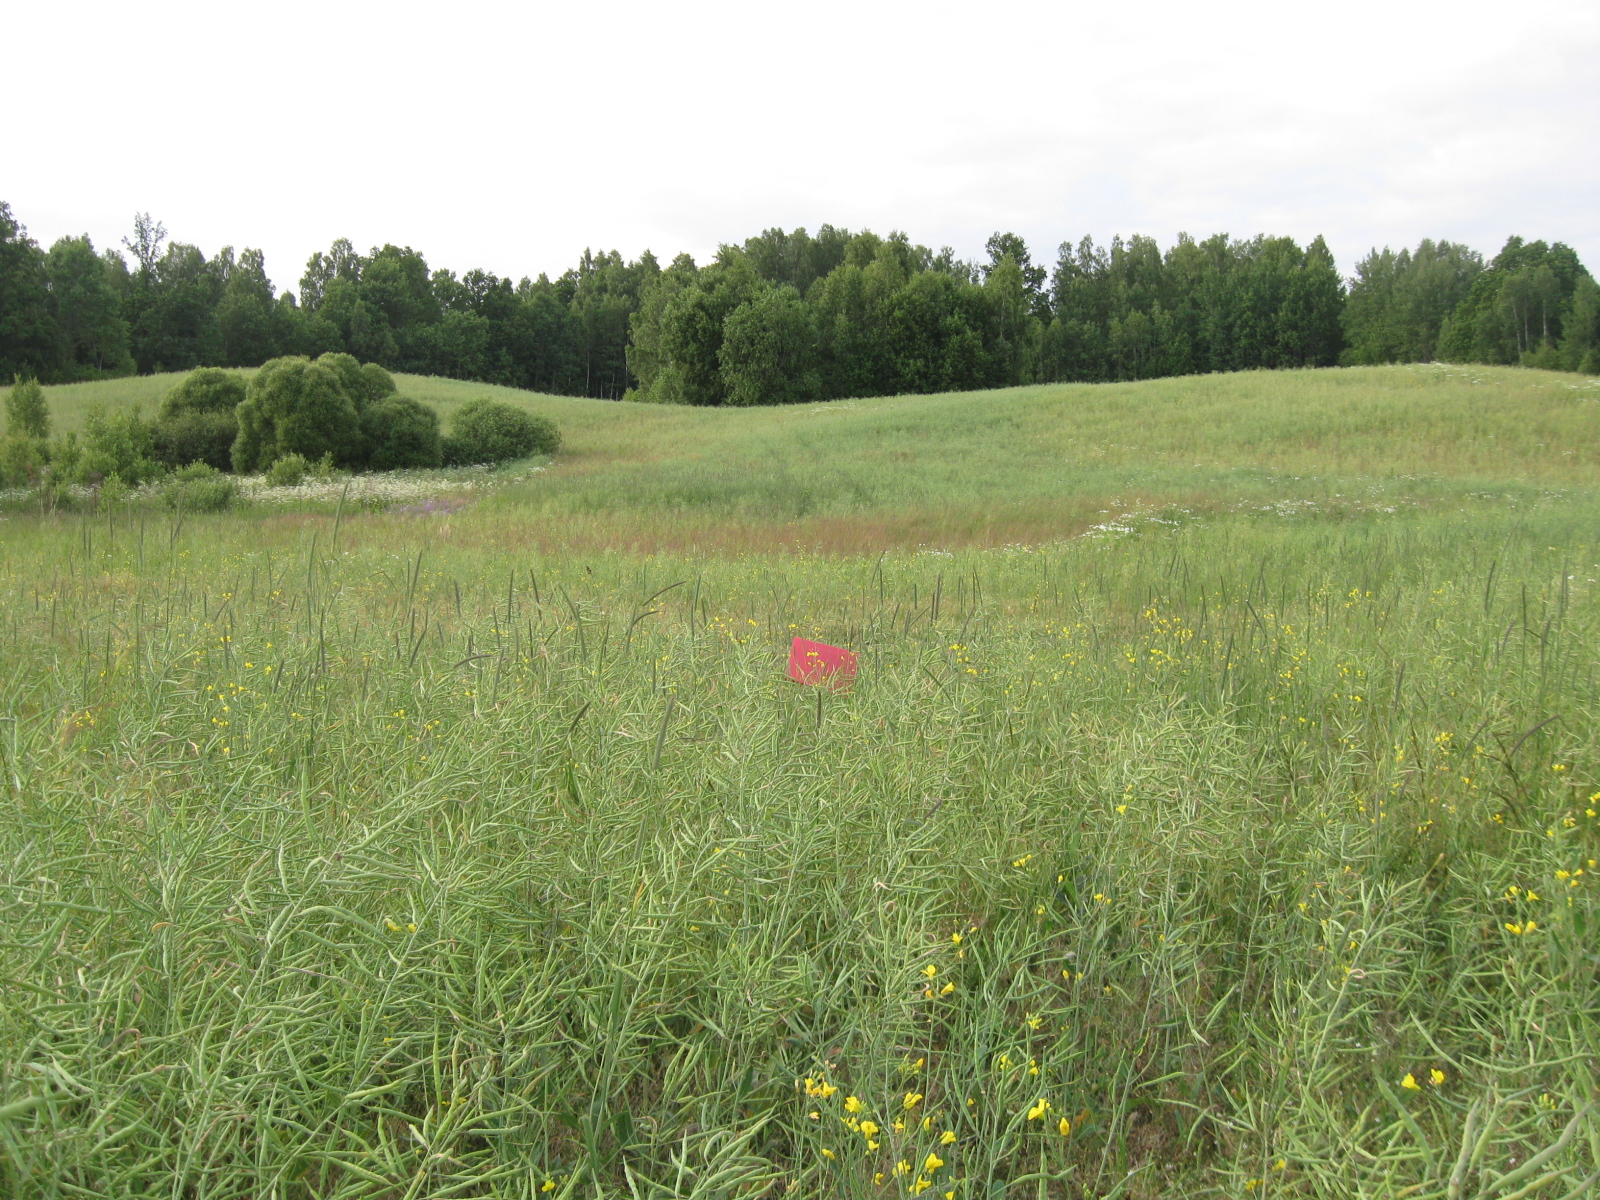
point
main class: Cropland
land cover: Rape and turnip rape
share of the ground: > 75 %
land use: Agriculture (excluding fallow land and kitchen gardens)
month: June
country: LT
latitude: 54.4123
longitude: 24.6049
